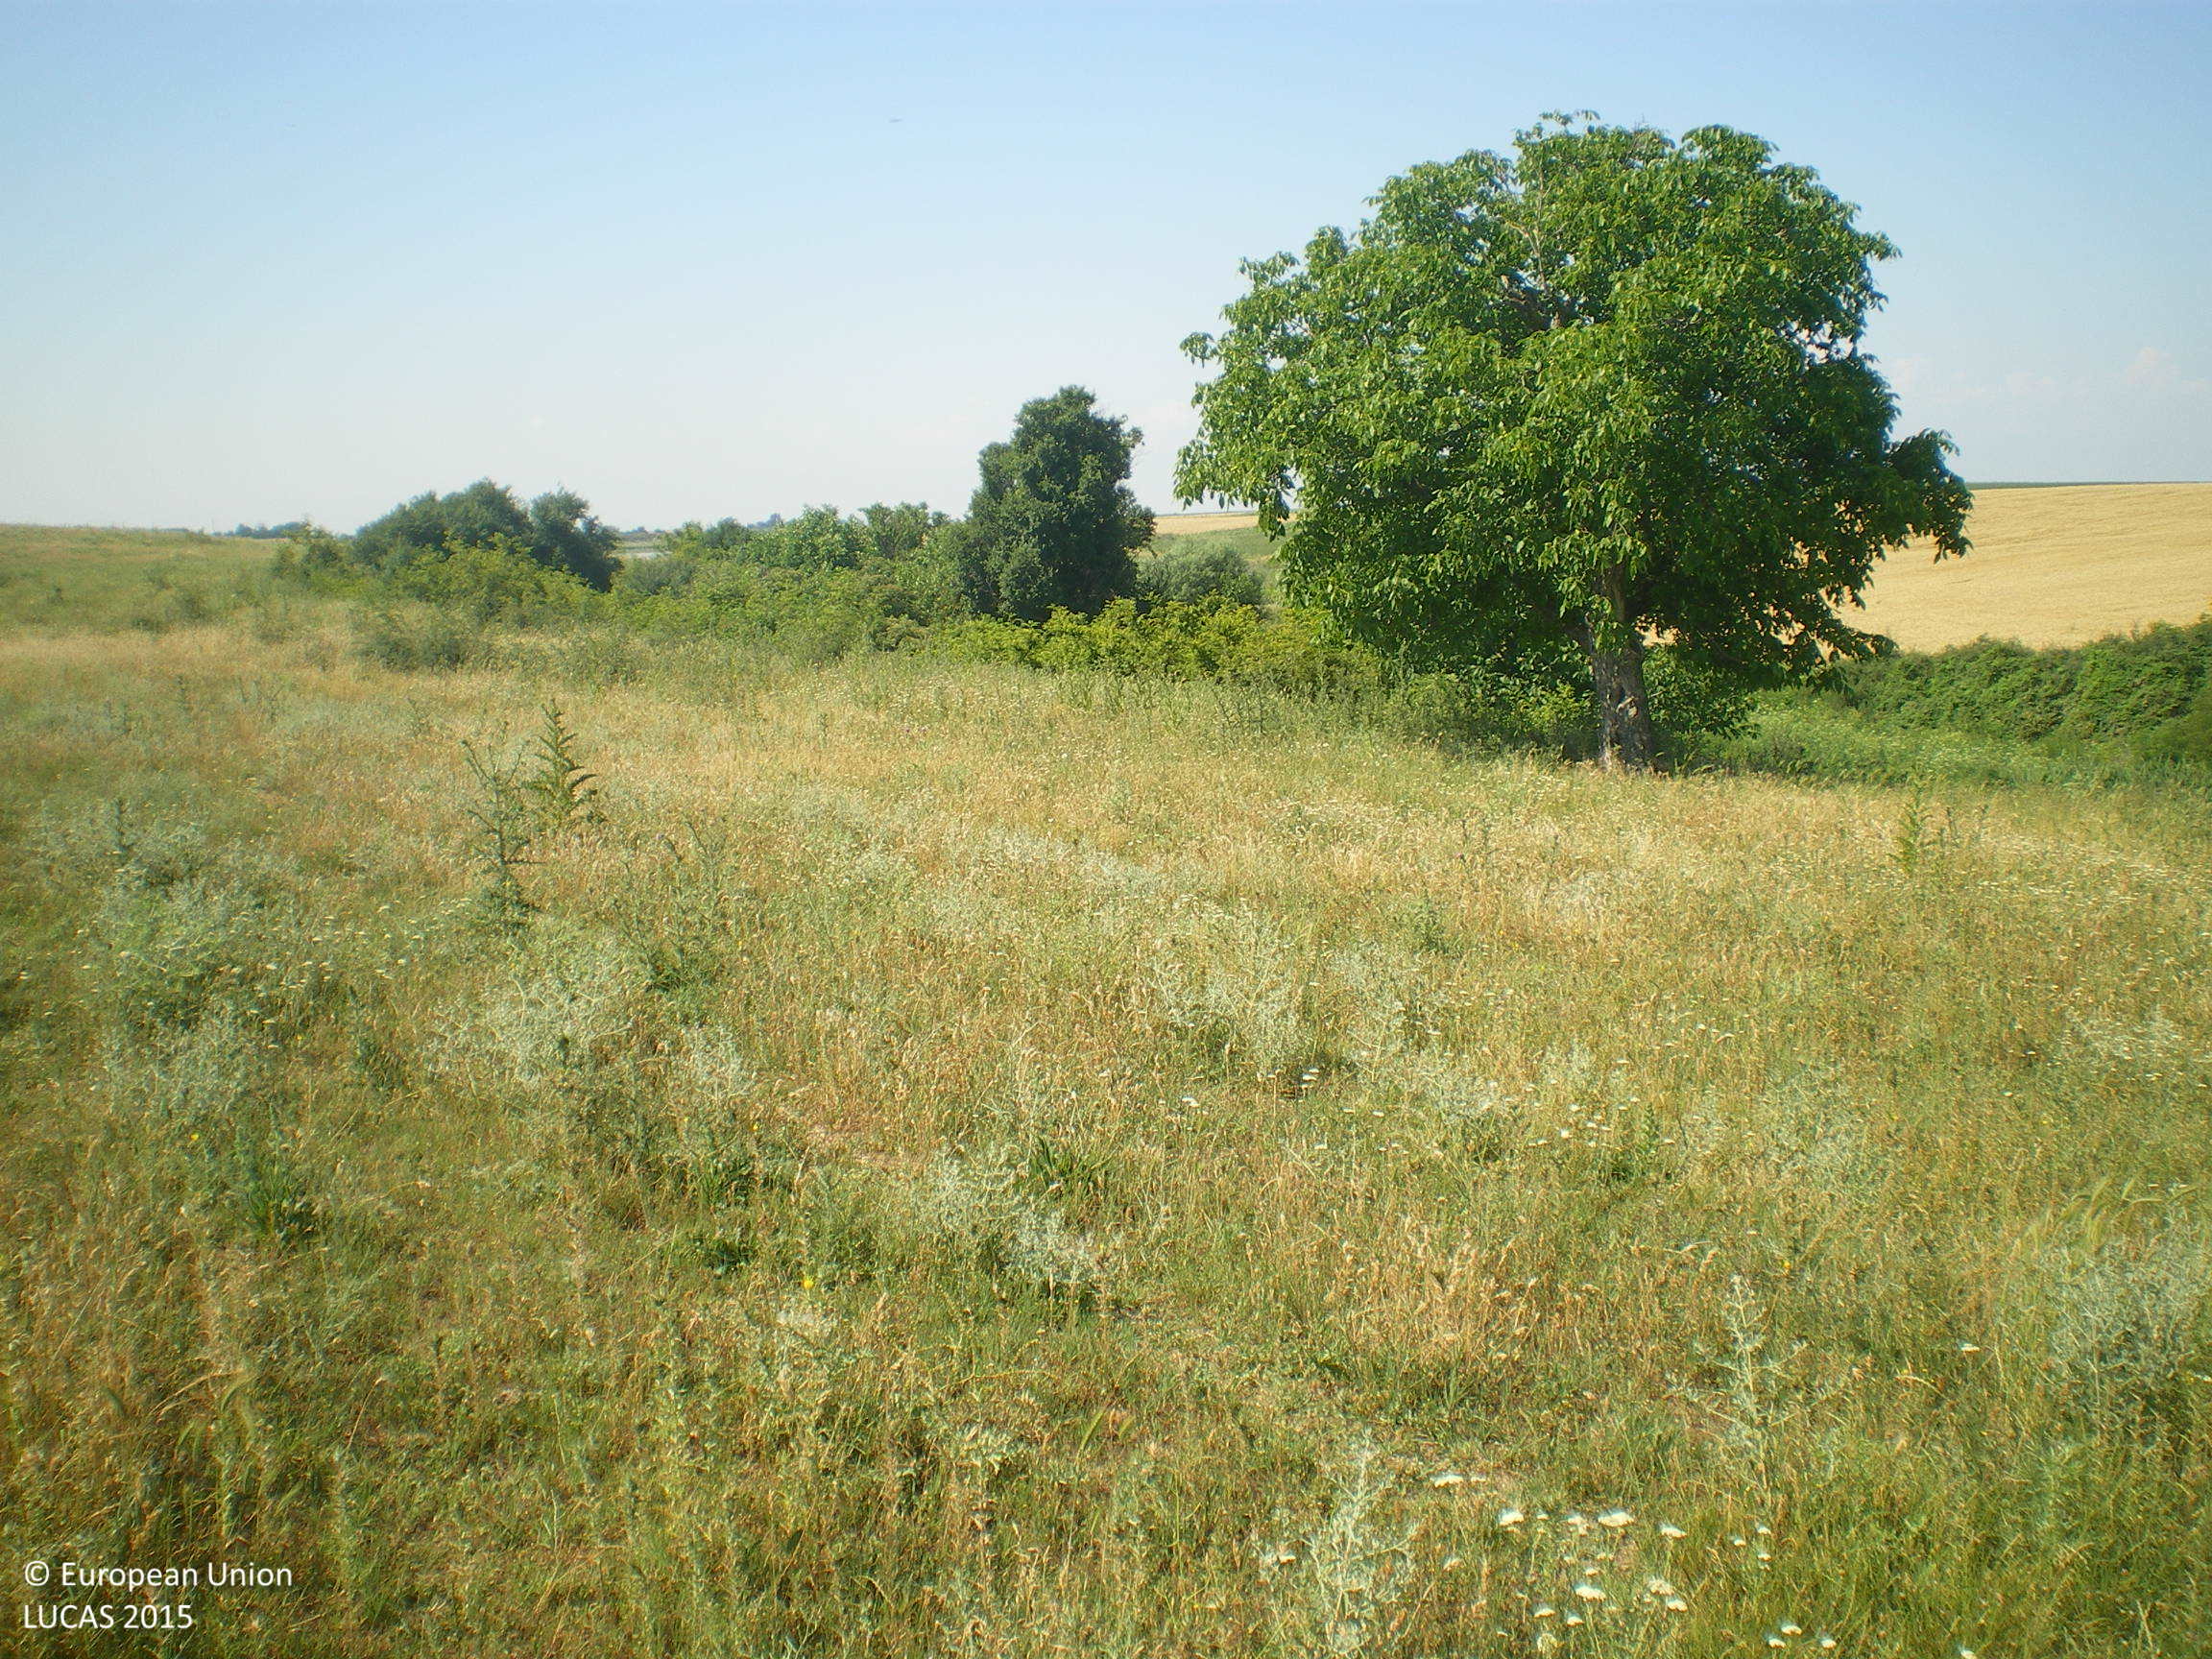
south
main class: Grassland
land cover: Spontaneously vegetated surfaces
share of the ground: > 75 %
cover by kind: herbaceous plants 100 %
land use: Fallow land
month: June
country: BG
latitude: 42.3327
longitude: 25.1464
